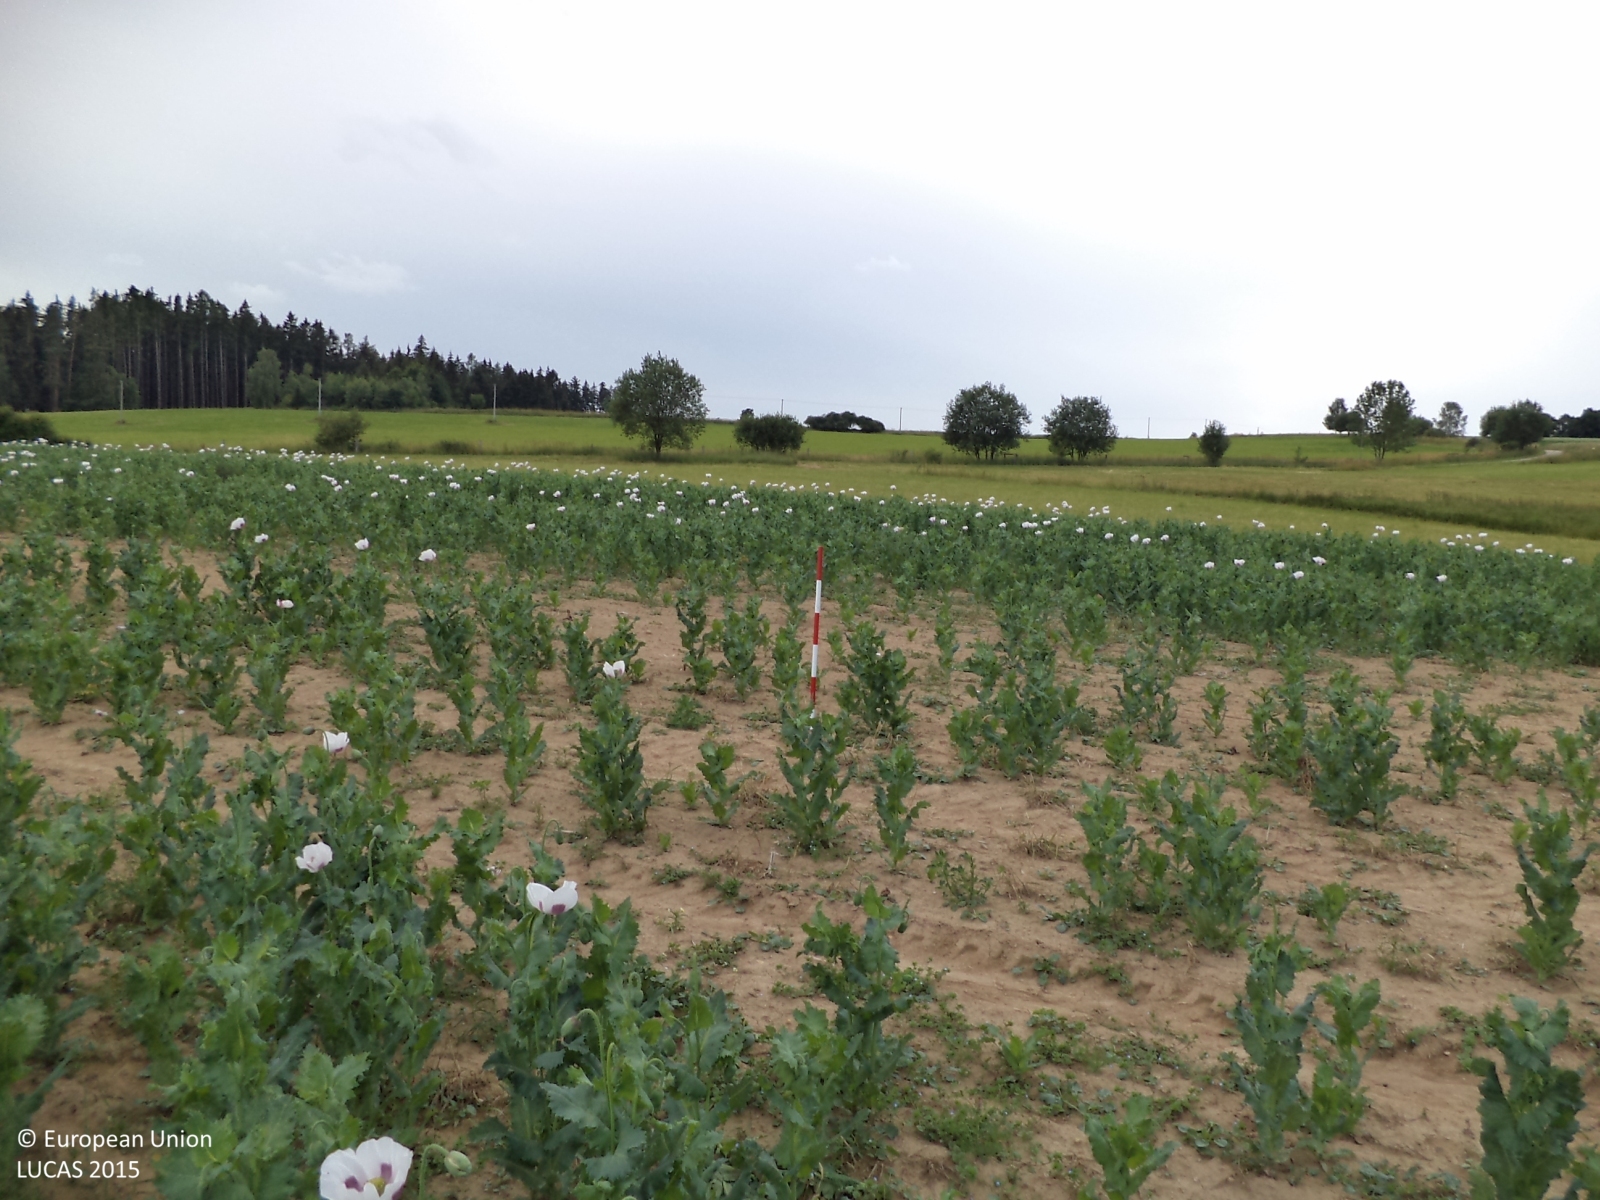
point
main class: Cropland
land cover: Other fibre and oleaginous crops
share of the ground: 50 - 75 %
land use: Agriculture (excluding fallow land and kitchen gardens)
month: June
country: CZ
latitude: 49.6505
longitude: 14.8083
